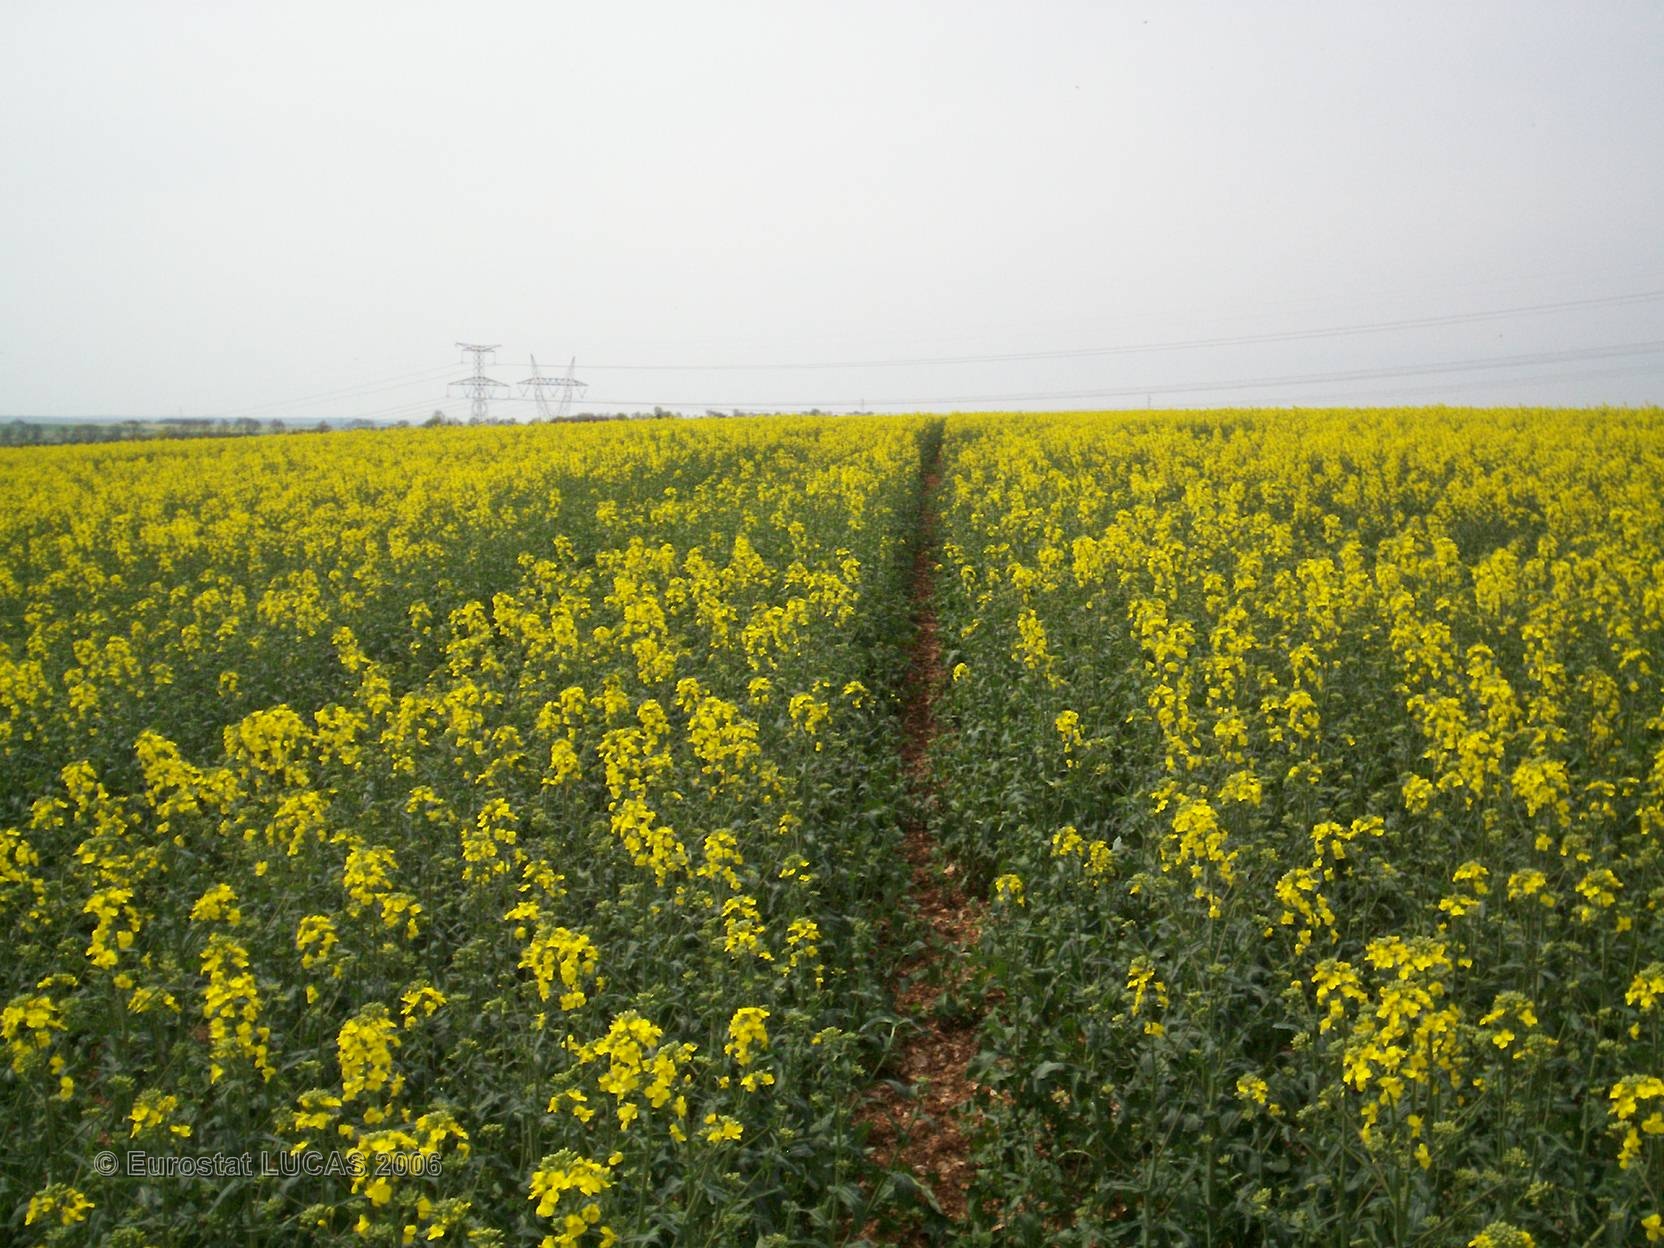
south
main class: Cropland
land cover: Rape and turnip rape
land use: Agriculture (excluding fallow land and kitchen gardens)
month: May
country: FR
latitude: 47.6202
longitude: 4.5570
